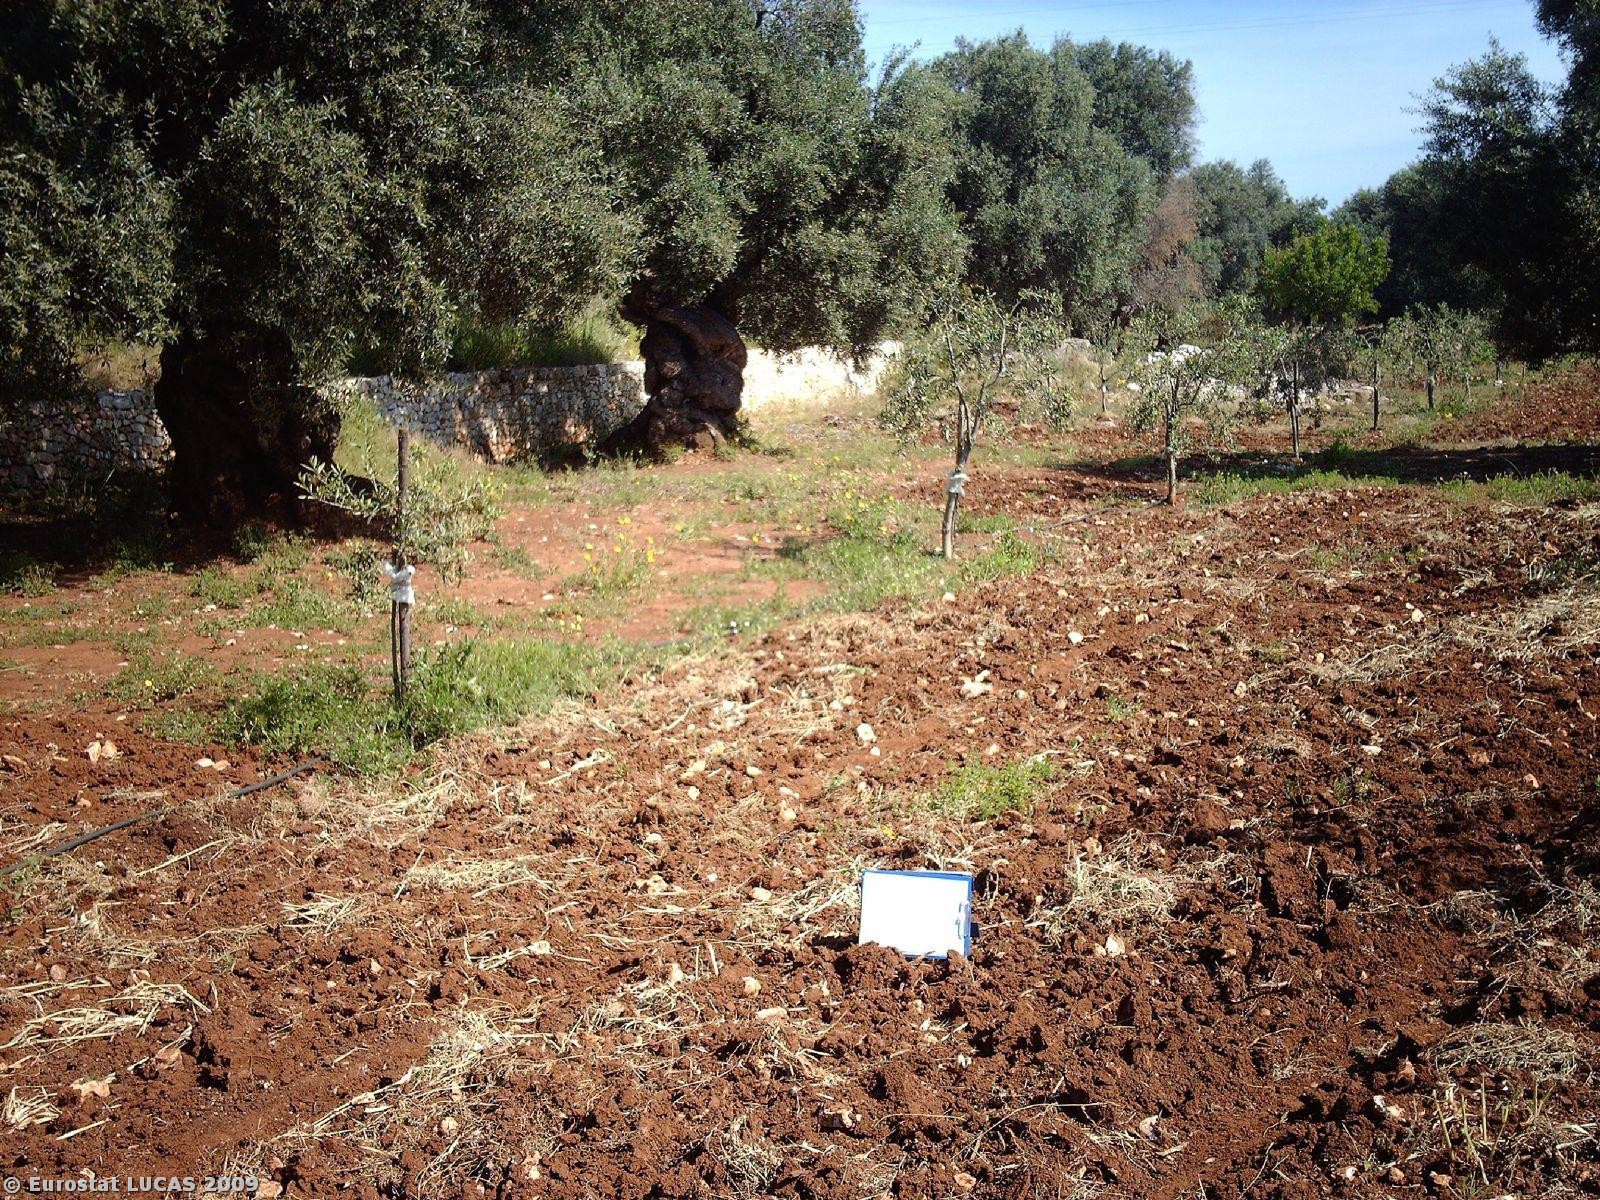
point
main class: Cropland
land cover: Olive groves
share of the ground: 10 - 25 %
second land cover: Bare land
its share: > 75 %
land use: Agriculture (excluding fallow land and kitchen gardens)
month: May
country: IT
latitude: 40.7574
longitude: 17.5466
